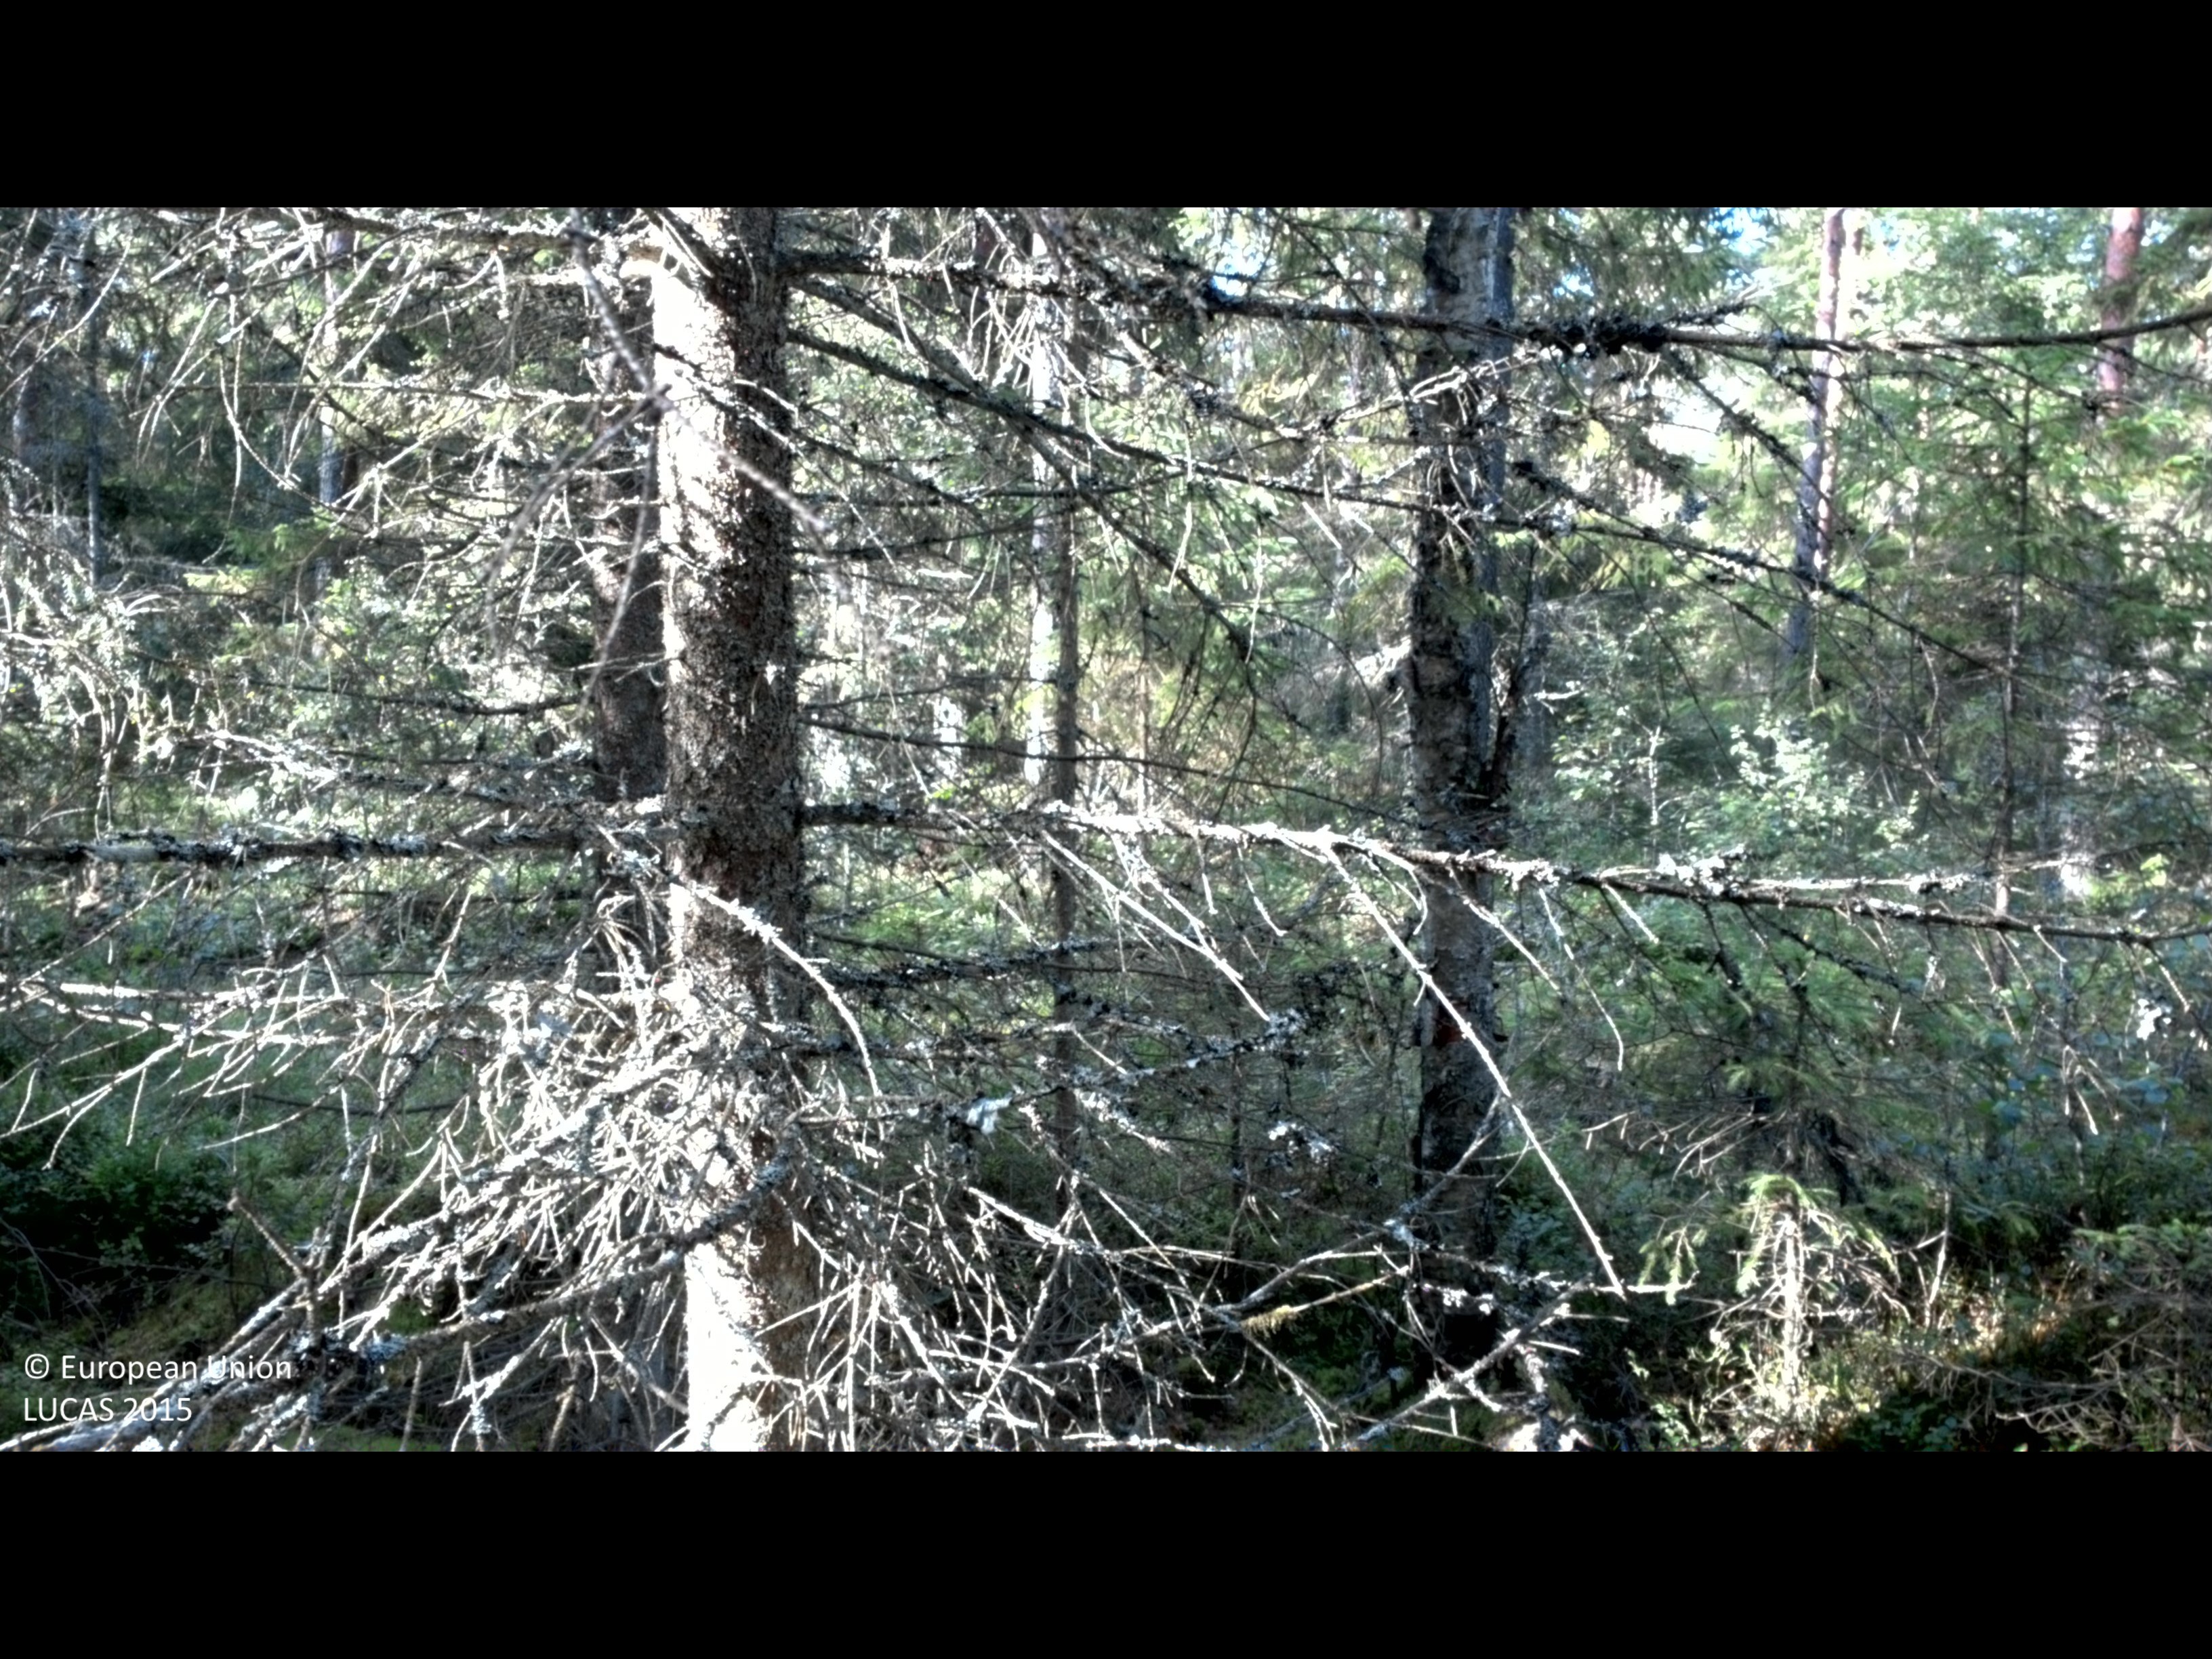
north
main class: Woodland
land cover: Other coniferous woodland
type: boreal forest
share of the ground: > 75 %
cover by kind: coniferous forest trees 80 %, shrubs 15 %, broadleaved forest trees 5 %
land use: Forestry
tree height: > 5 m
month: August
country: SE
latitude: 56.8431
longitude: 14.0787
